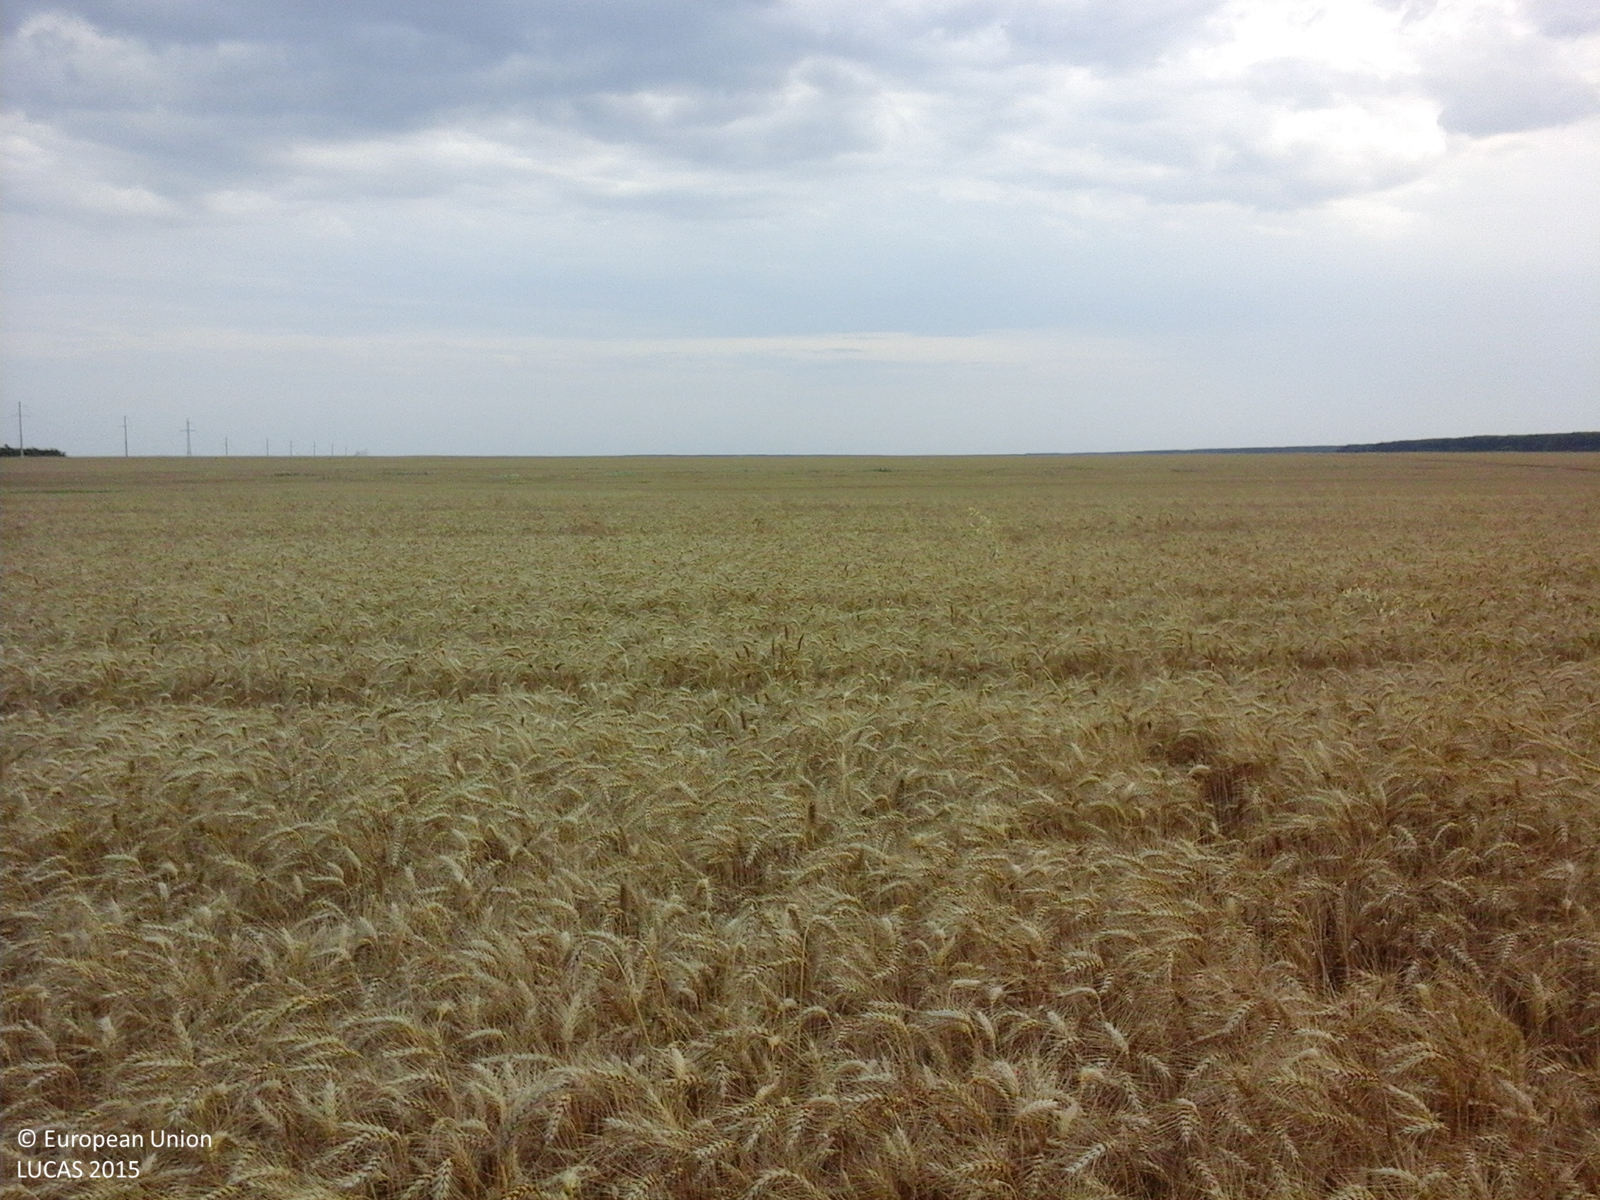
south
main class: Cropland
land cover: Common wheat
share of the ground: > 75 %
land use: Agriculture (excluding fallow land and kitchen gardens)
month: June
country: RO
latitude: 44.1693
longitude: 26.2006
